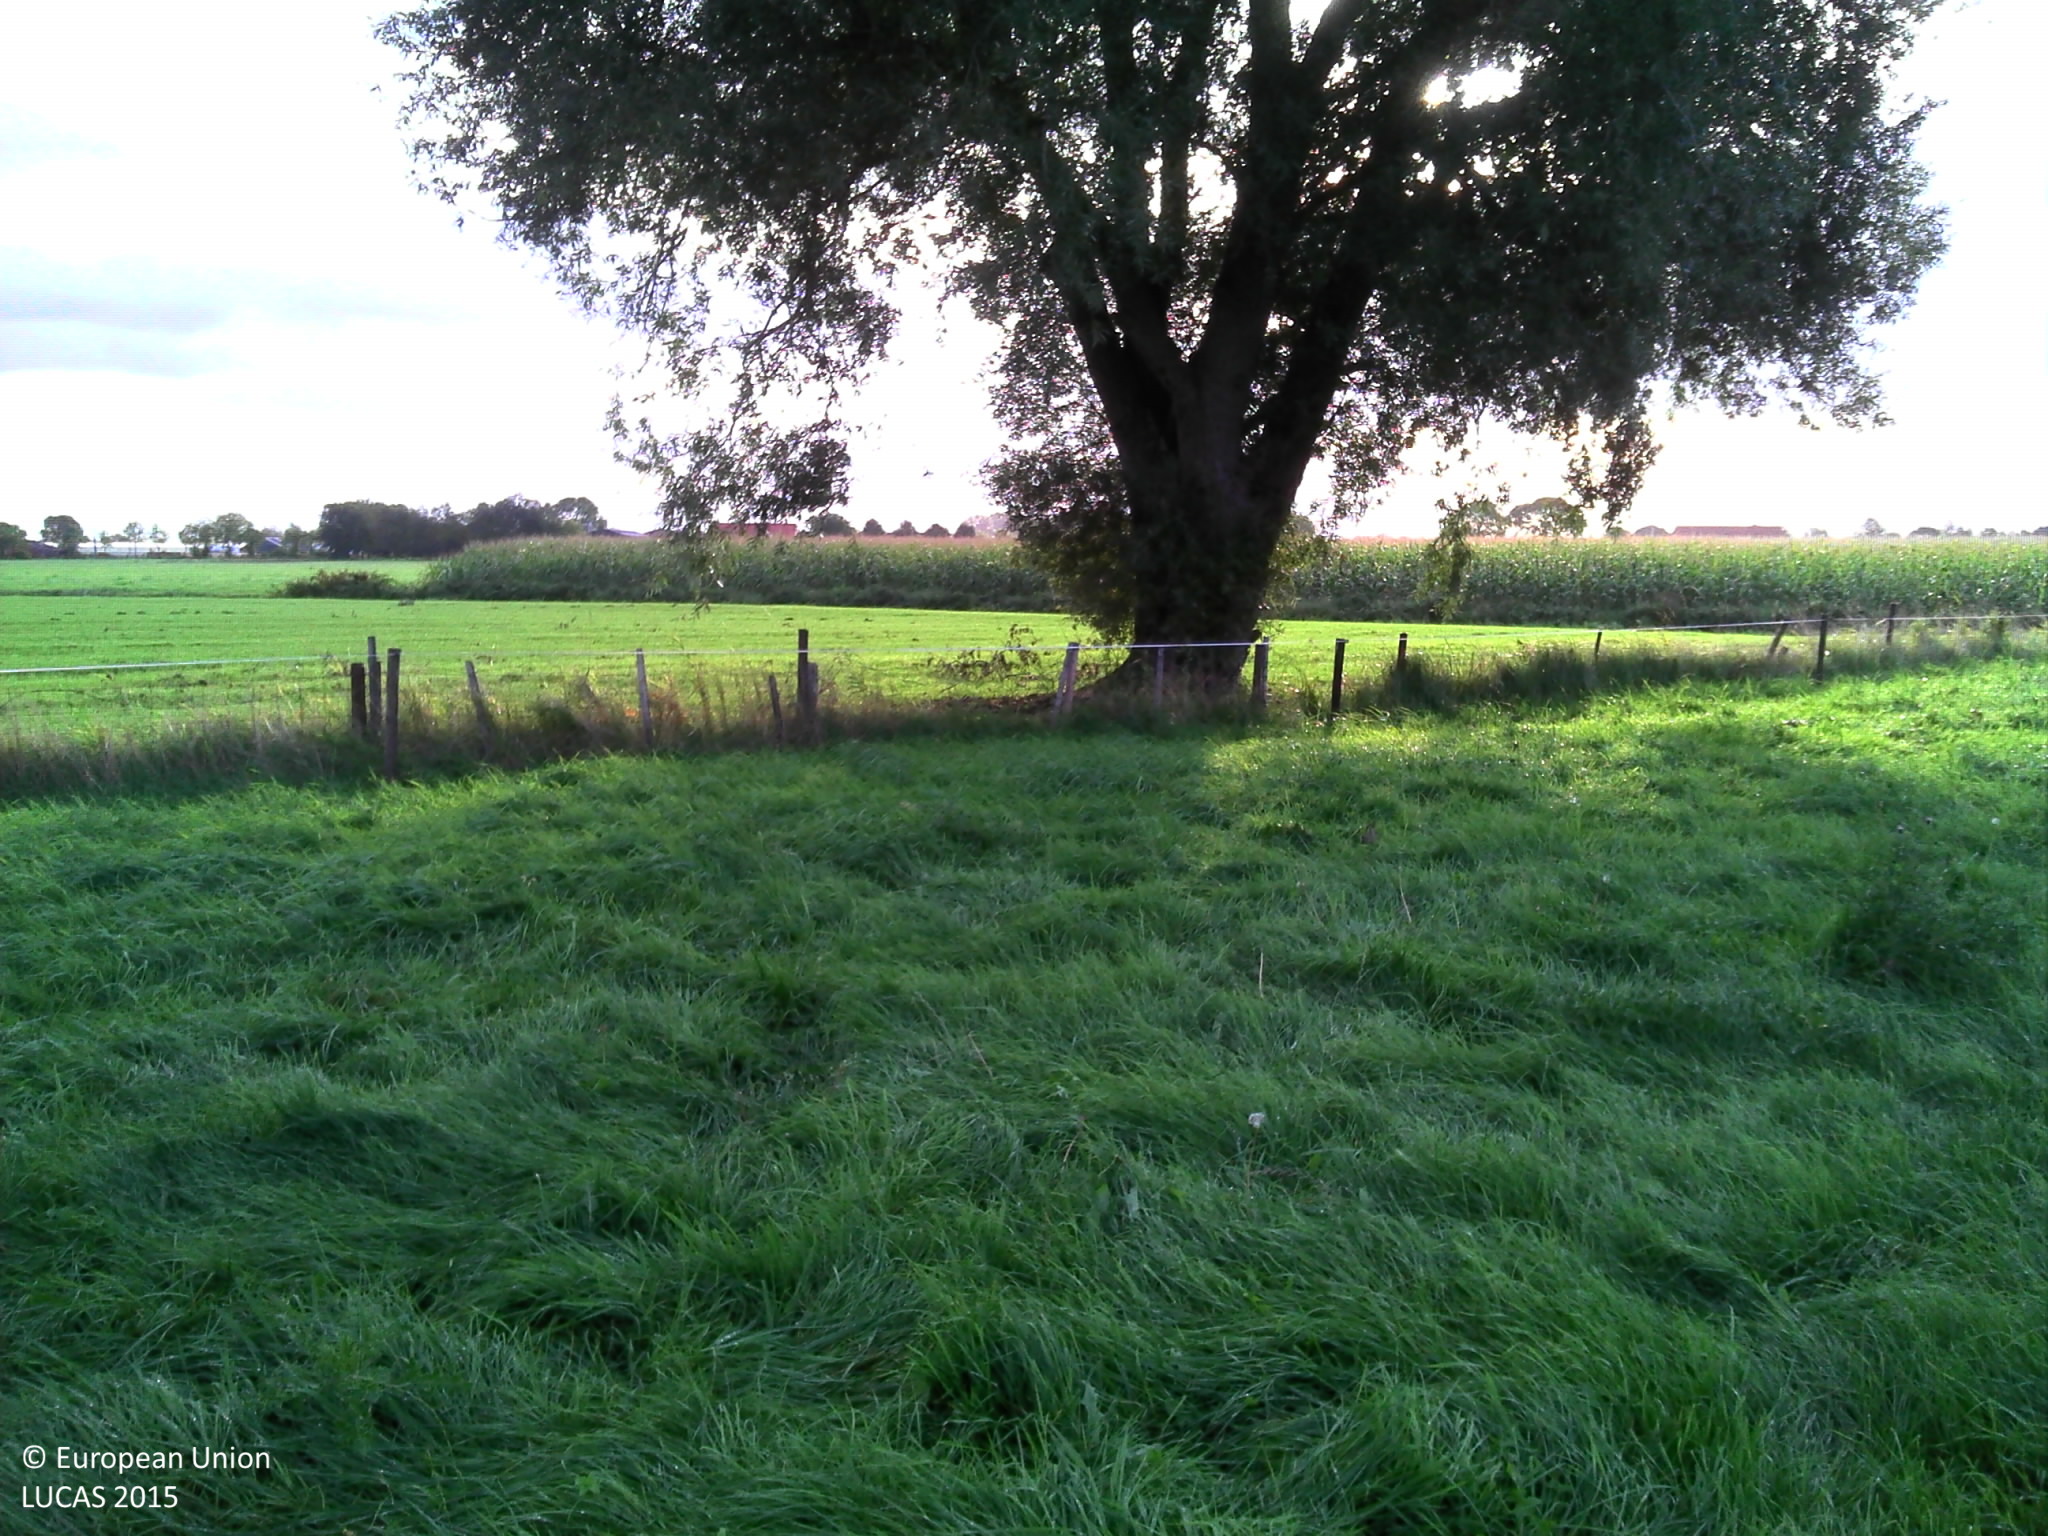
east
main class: Grassland
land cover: Grassland without tree/shrub cover
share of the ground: > 75 %
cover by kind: herbaceous plants 100 %
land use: Agriculture (excluding fallow land and kitchen gardens)
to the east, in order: Grassland without tree/shrub cover; Fences; Grass margins; Ditches and canals; Single bushes/trees; Fences; Temporary grasslands; Grass margins; Ditches and canals; Grass margins; Maize; Grass margins; Ditches and canals; Temporary grasslands
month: September
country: BE
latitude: 51.4094
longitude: 4.6336
